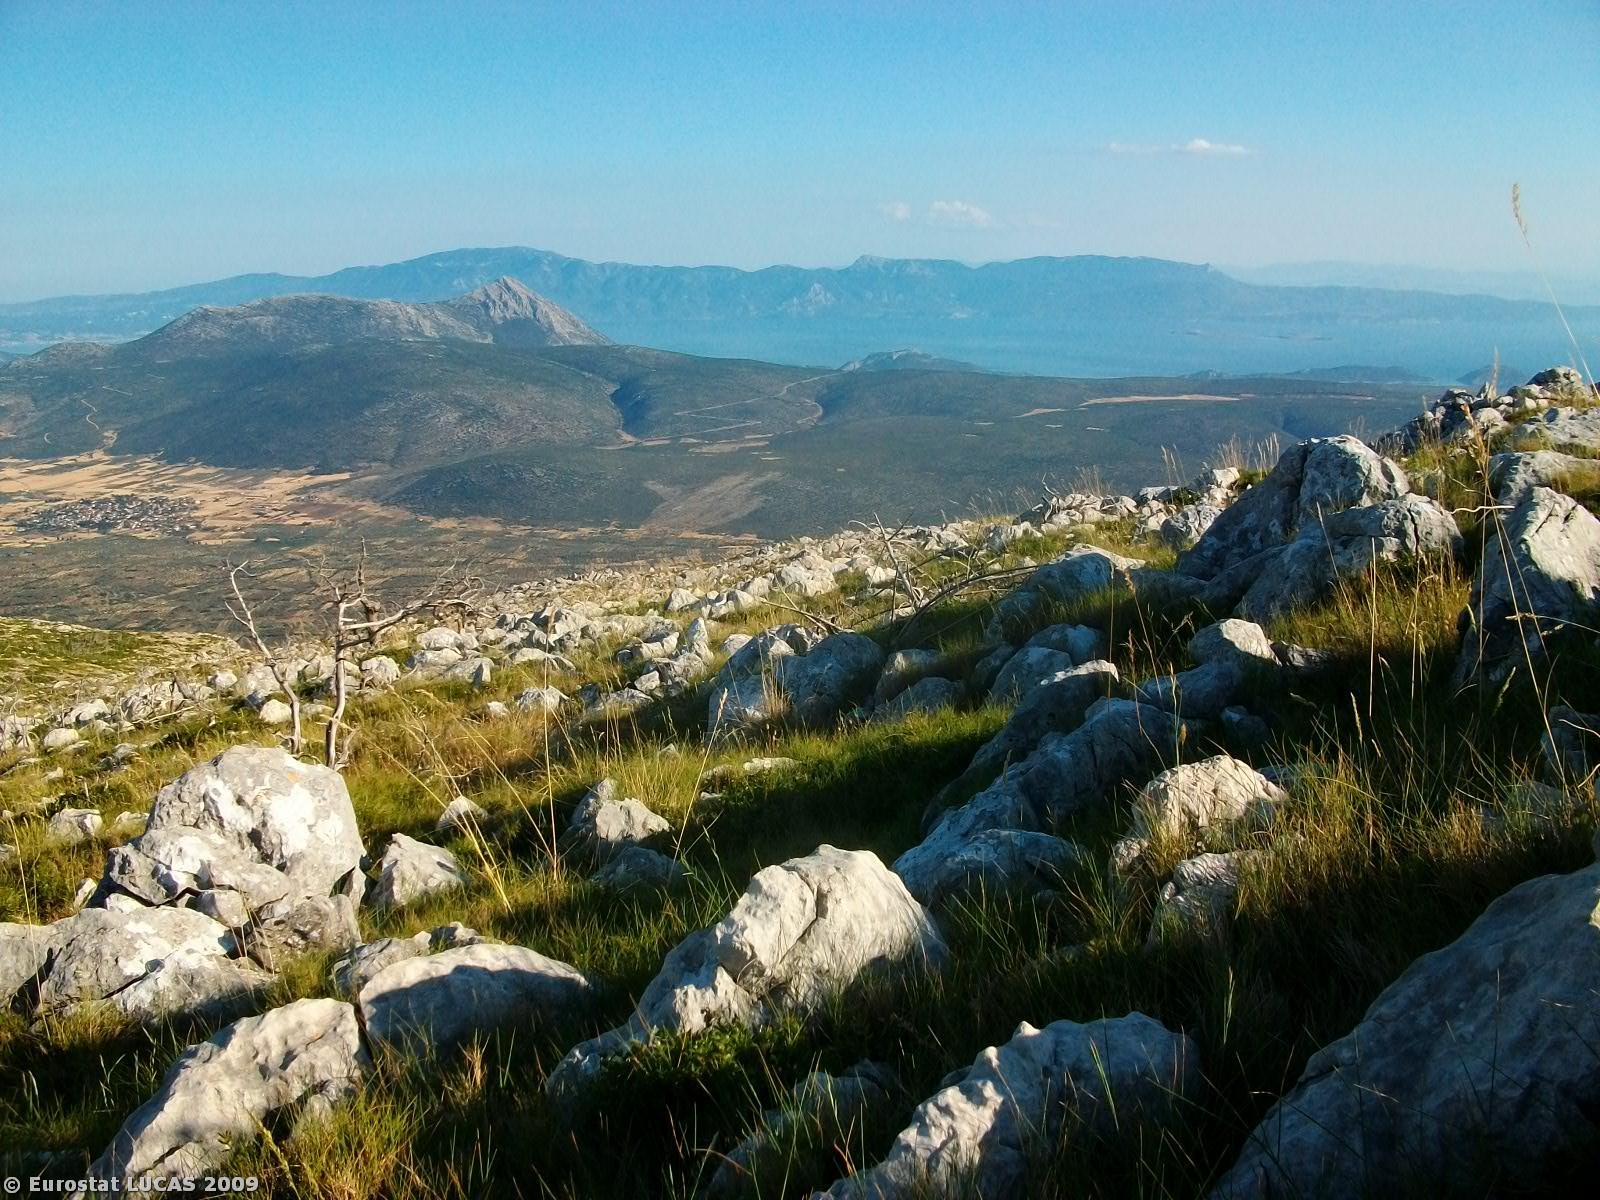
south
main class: Shrubland
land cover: Shrubland without tree cover
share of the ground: 50 - 75 %
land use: Agriculture (excluding fallow land and kitchen gardens)
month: June
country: GR
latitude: 38.2931
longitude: 23.0468
